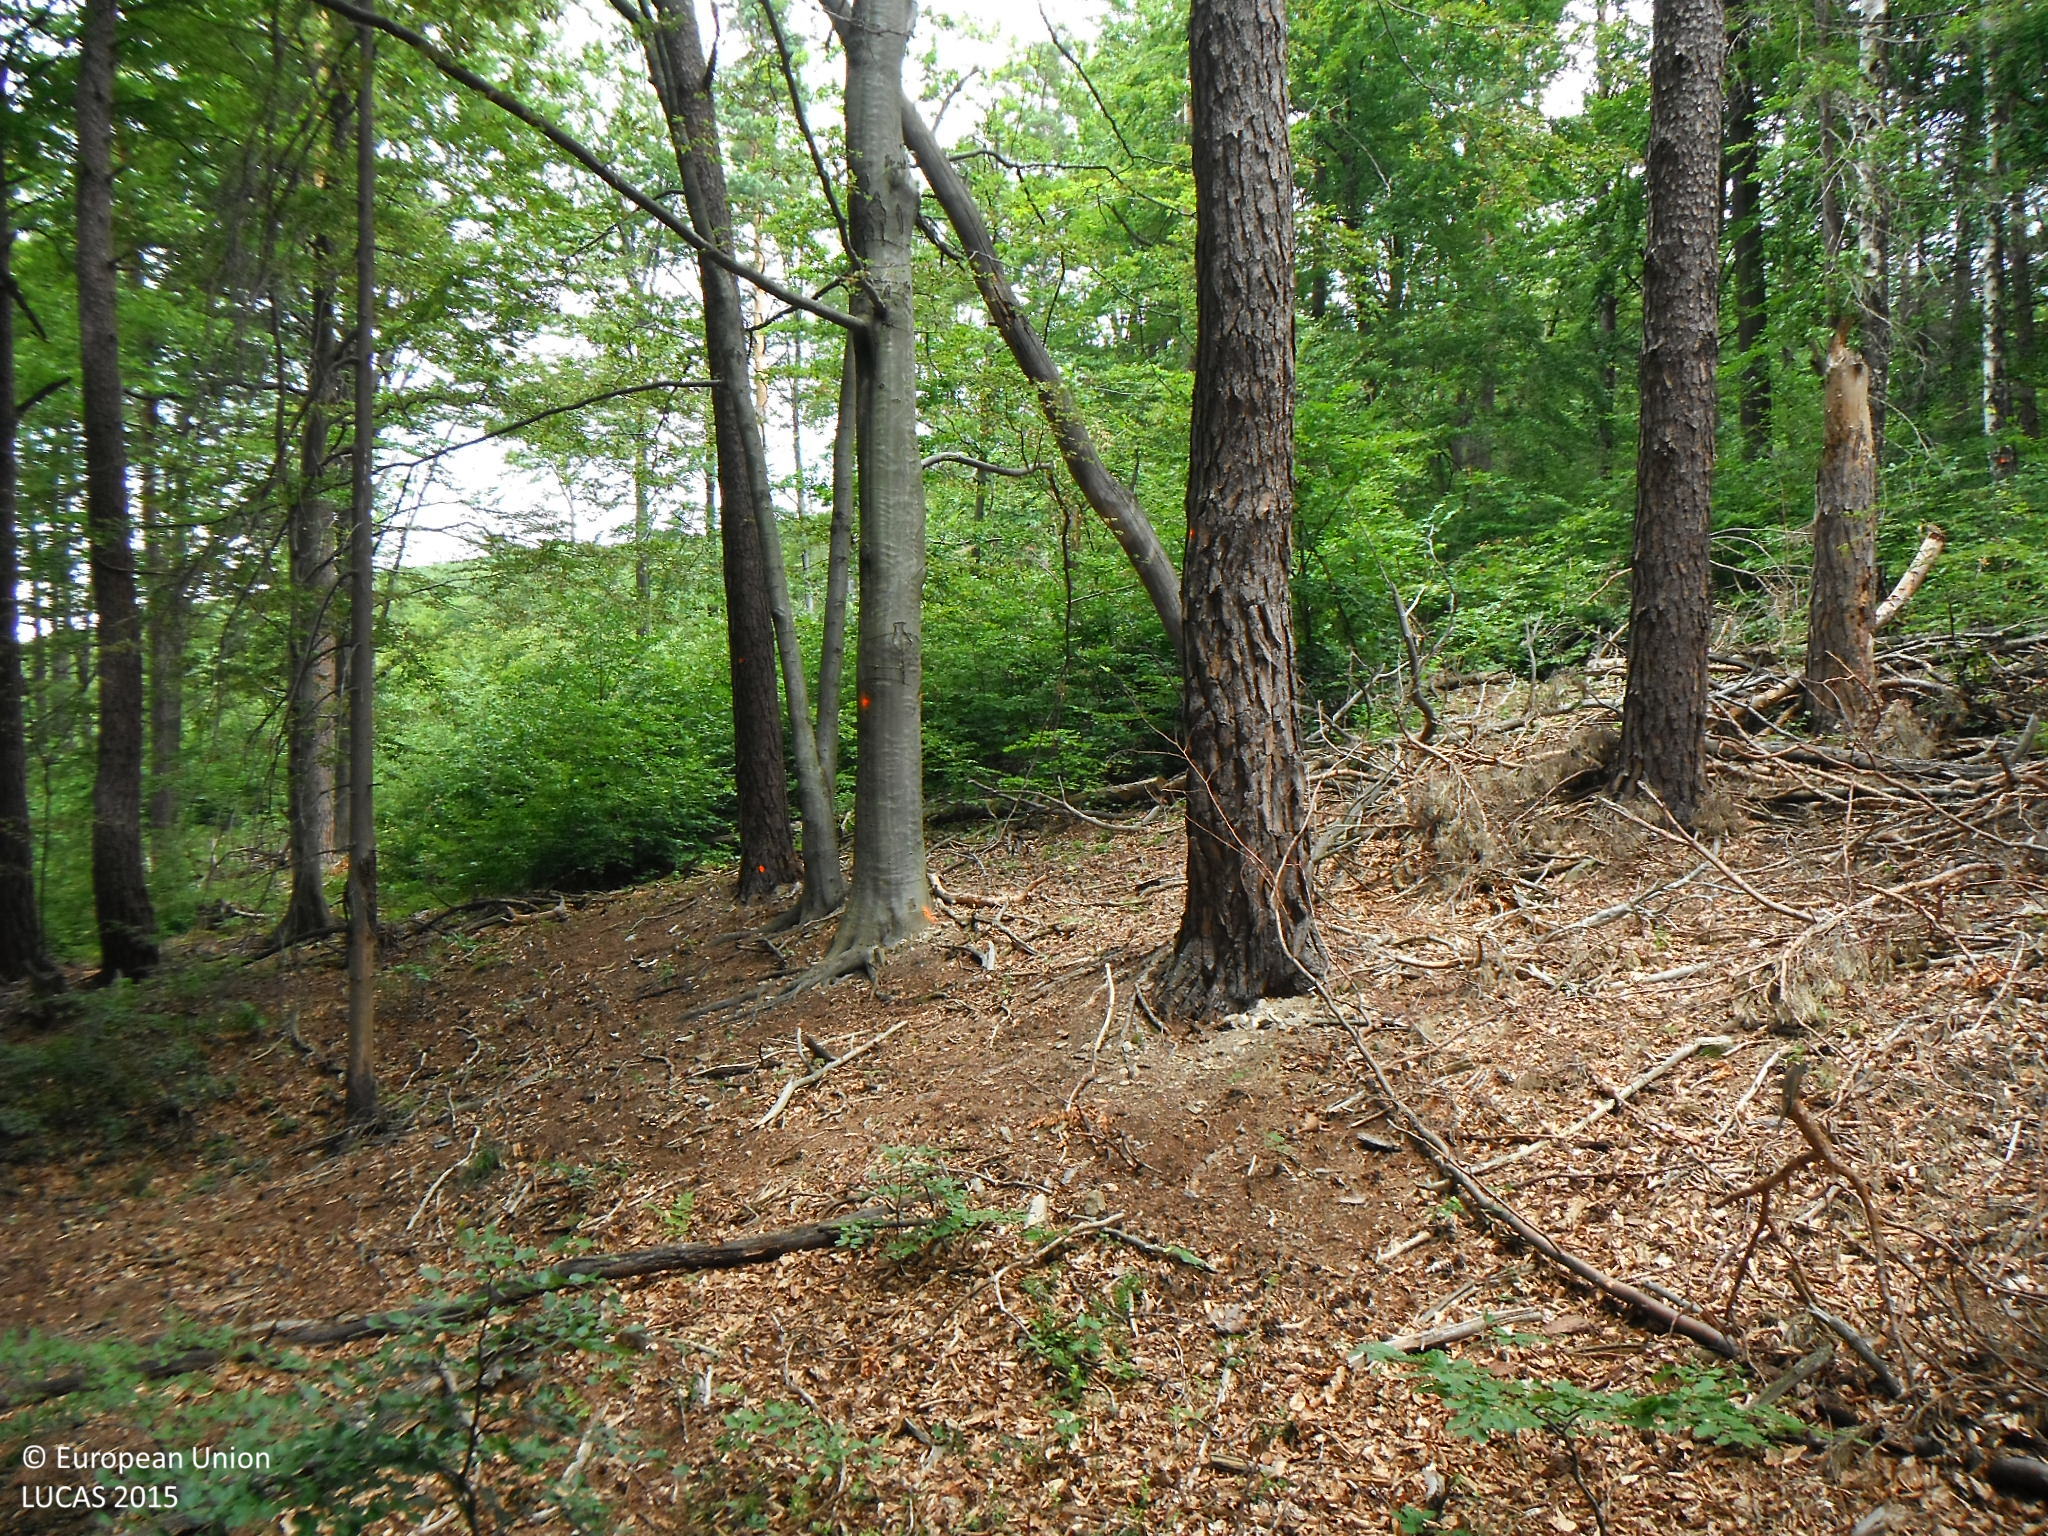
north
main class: Woodland
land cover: Pine dominated mixed woodland
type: hemiboreal forest and nemoral coniferous forest and mixed broadleaved-coniferous forest
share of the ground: 50 - 75 %
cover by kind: coniferous forest trees 65 %, broadleaved forest trees 35 %
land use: Forestry
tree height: > 5 m
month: July
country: SK
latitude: 48.7383
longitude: 21.0423
